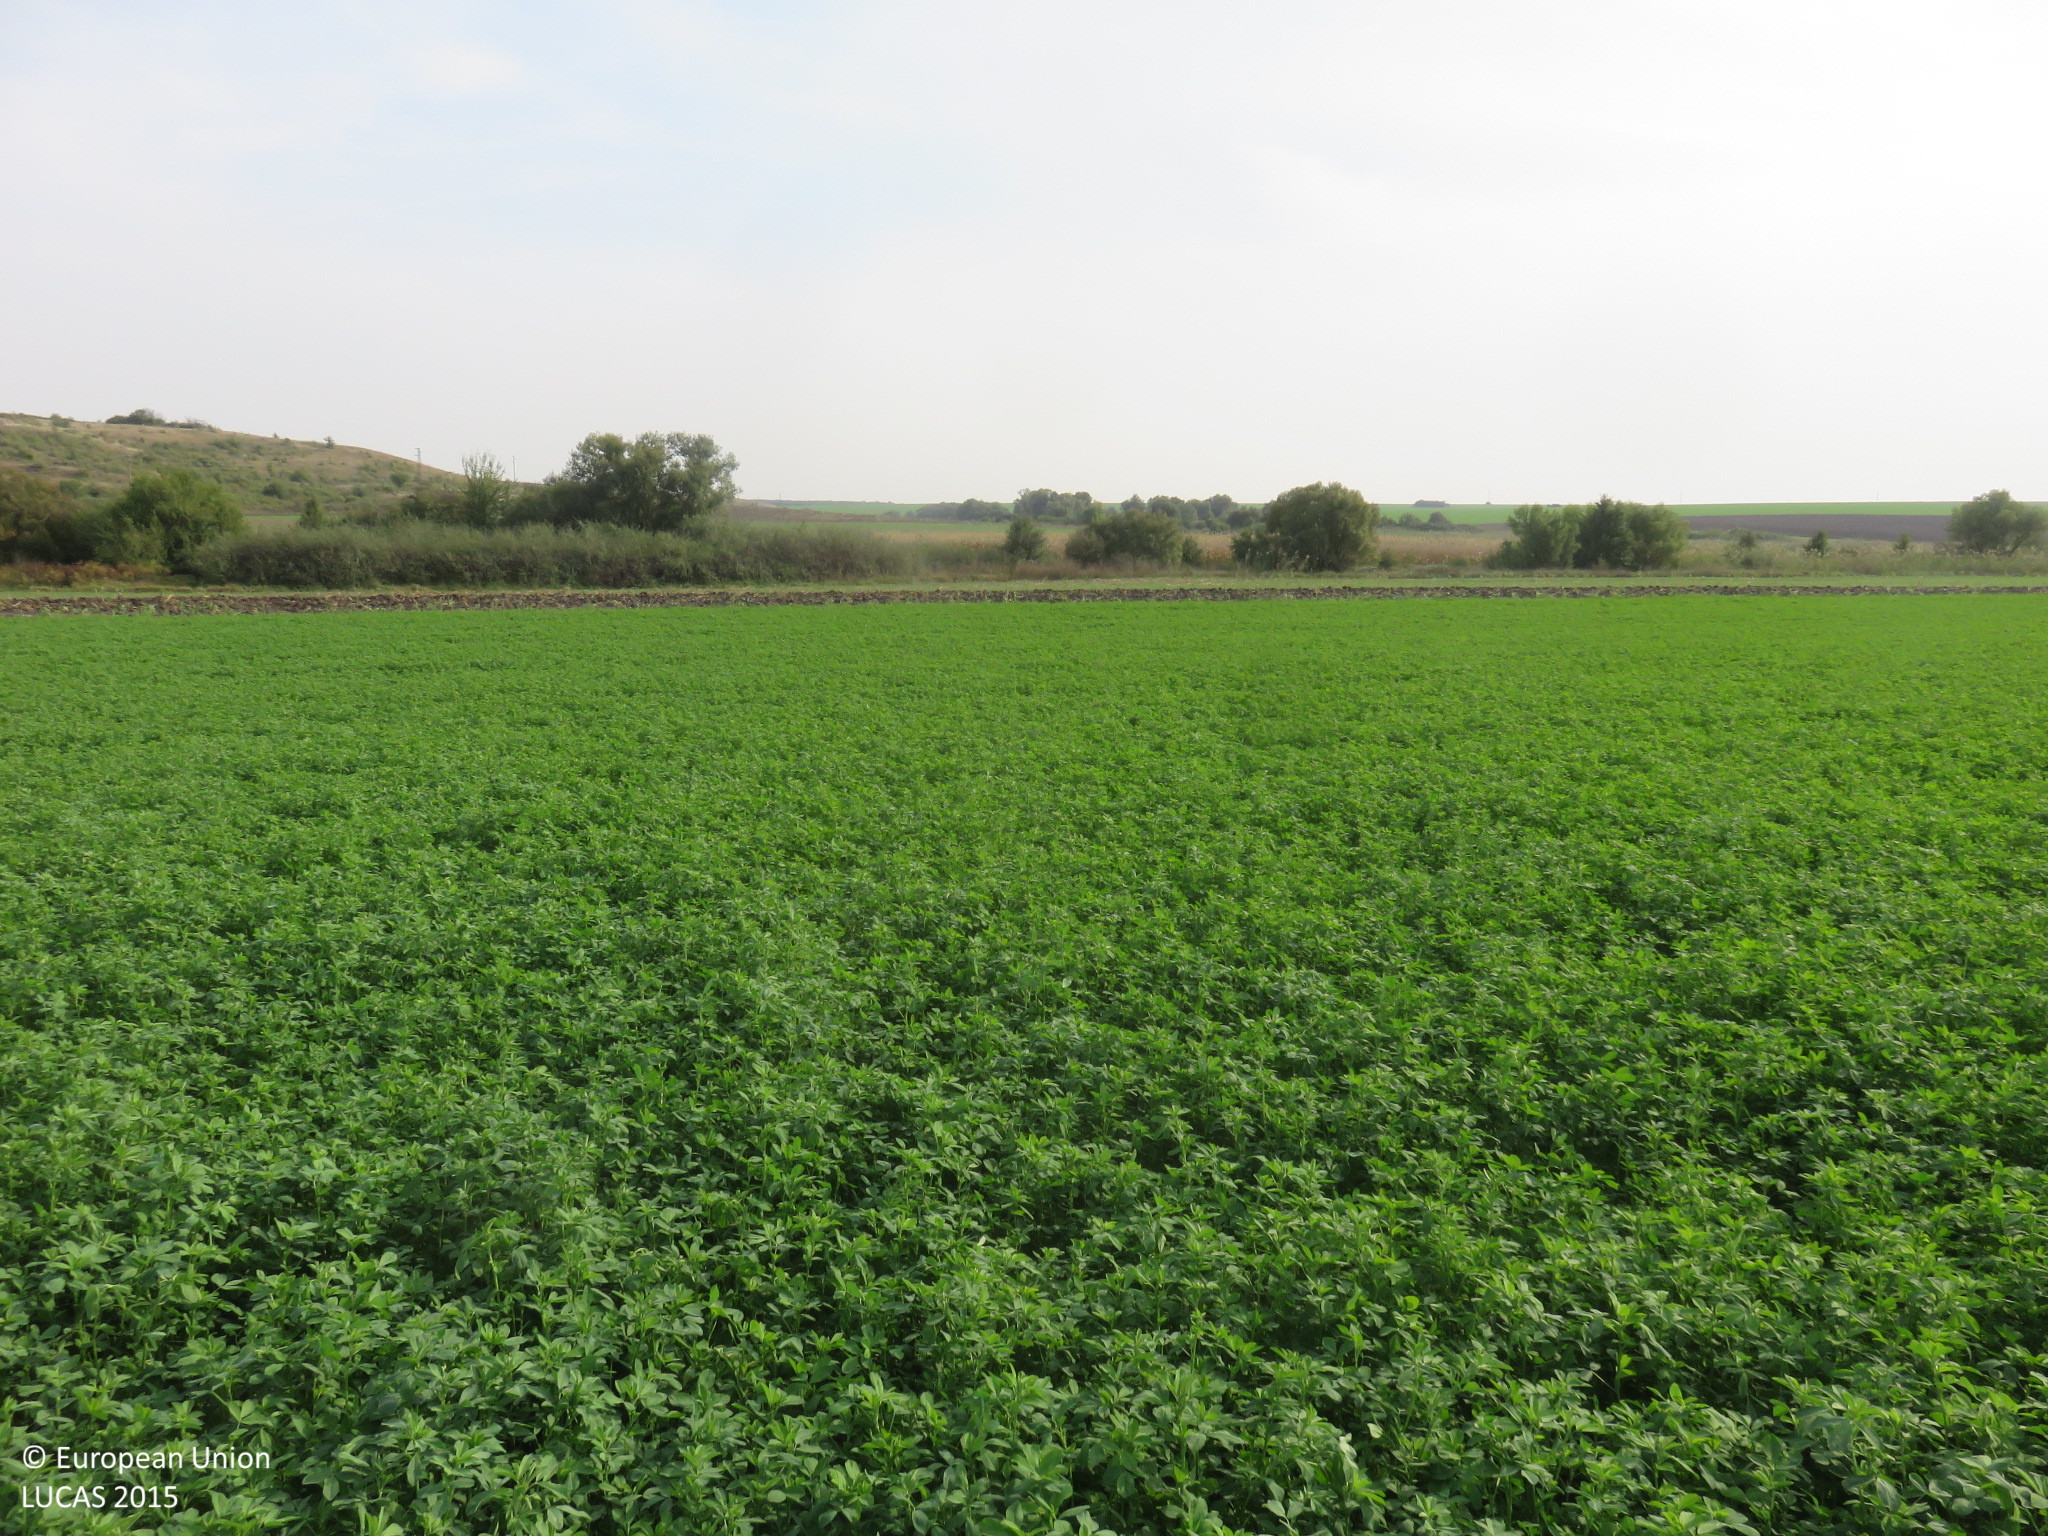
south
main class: Cropland
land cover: Lucerne
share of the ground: > 75 %
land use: Agriculture (excluding fallow land and kitchen gardens)
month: September
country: BG
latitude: 43.4106
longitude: 24.9250
